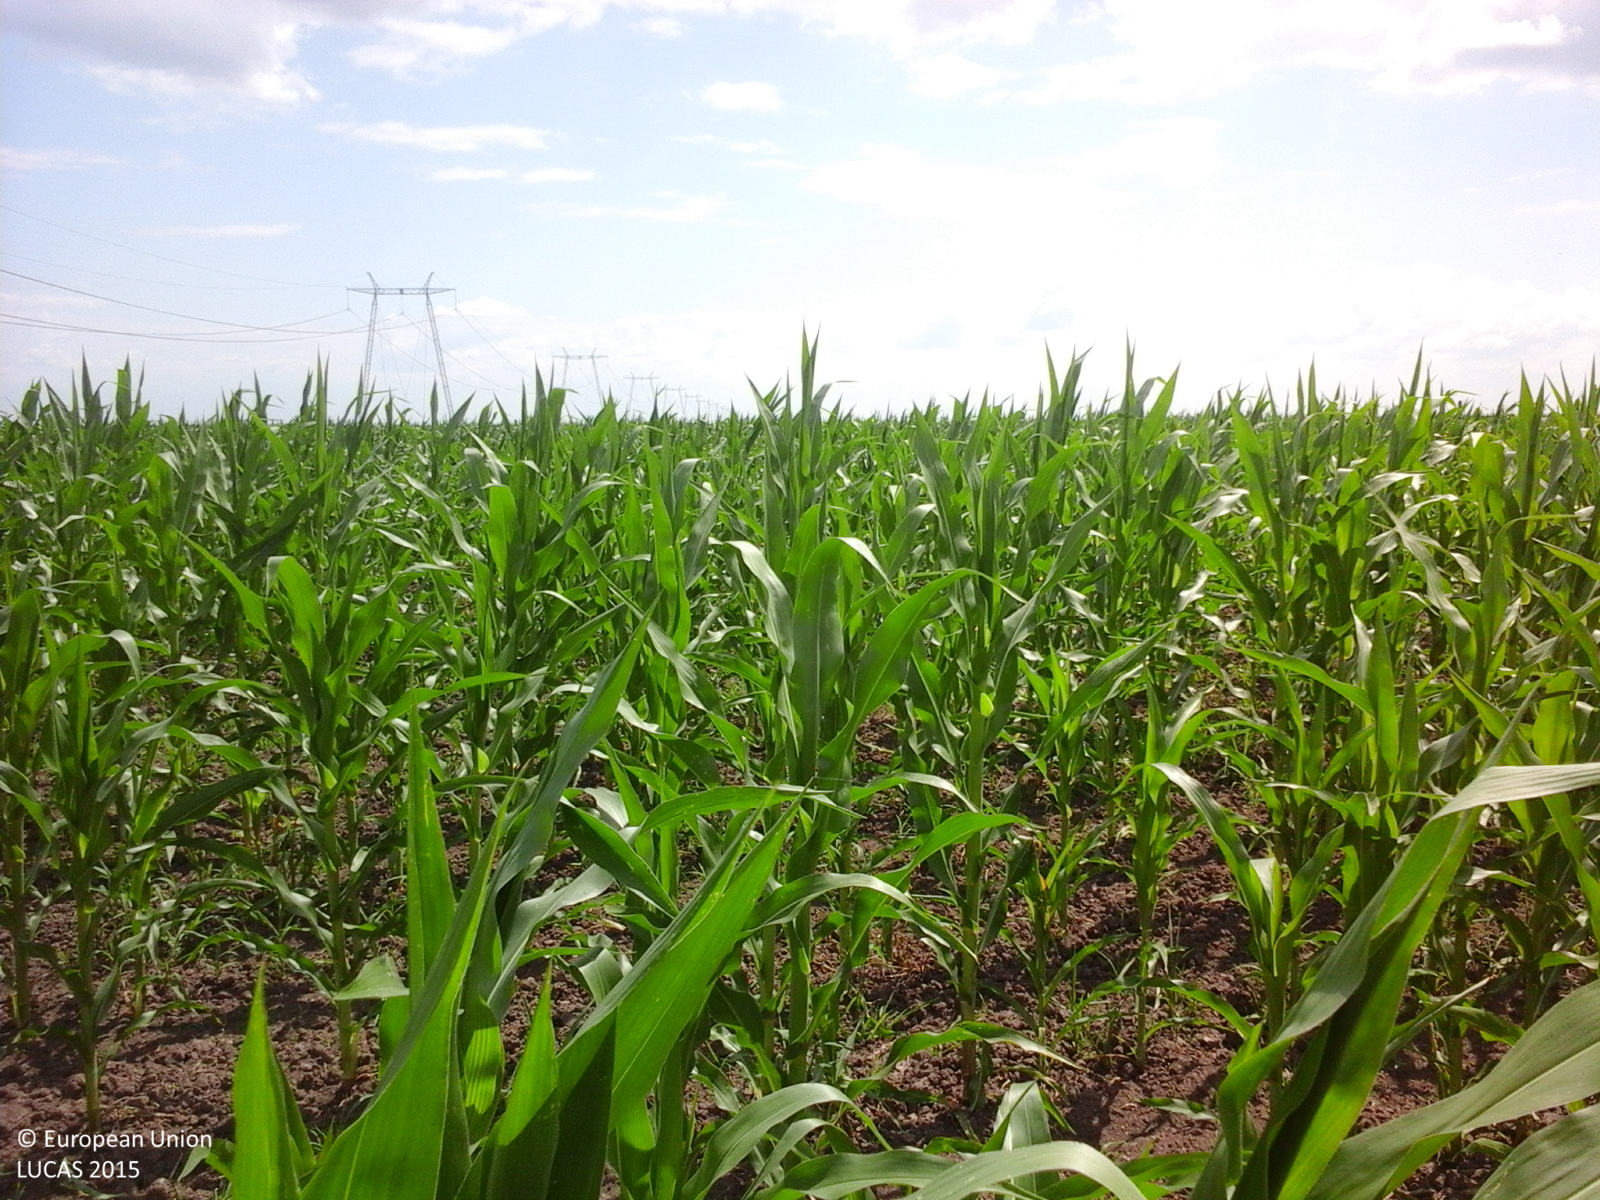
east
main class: Cropland
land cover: Maize
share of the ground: > 75 %
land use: Agriculture (excluding fallow land and kitchen gardens)
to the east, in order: Maize
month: July
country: RO
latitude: 44.2554
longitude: 25.4050
